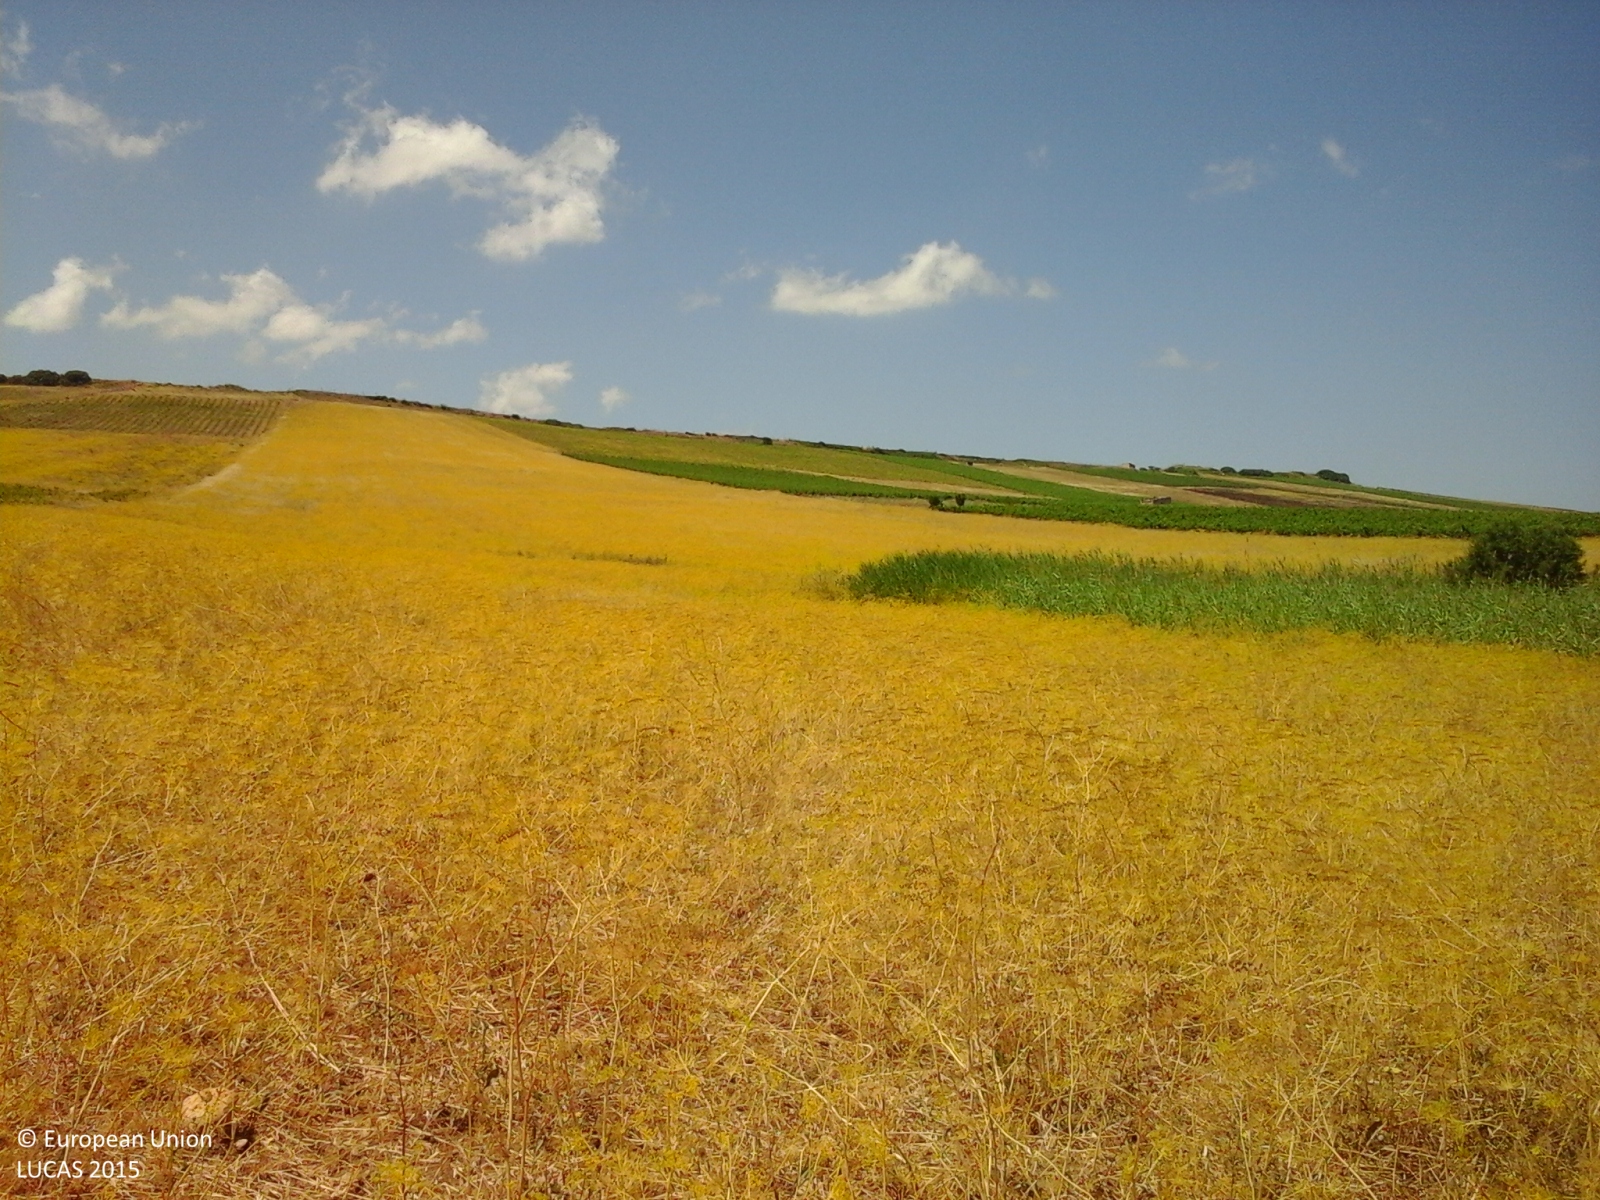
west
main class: Grassland
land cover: Spontaneously vegetated surfaces
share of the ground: > 75 %
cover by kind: herbaceous plants 100 %
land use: Agriculture (excluding fallow land and kitchen gardens)
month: June
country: IT
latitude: 37.7464
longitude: 12.6697
